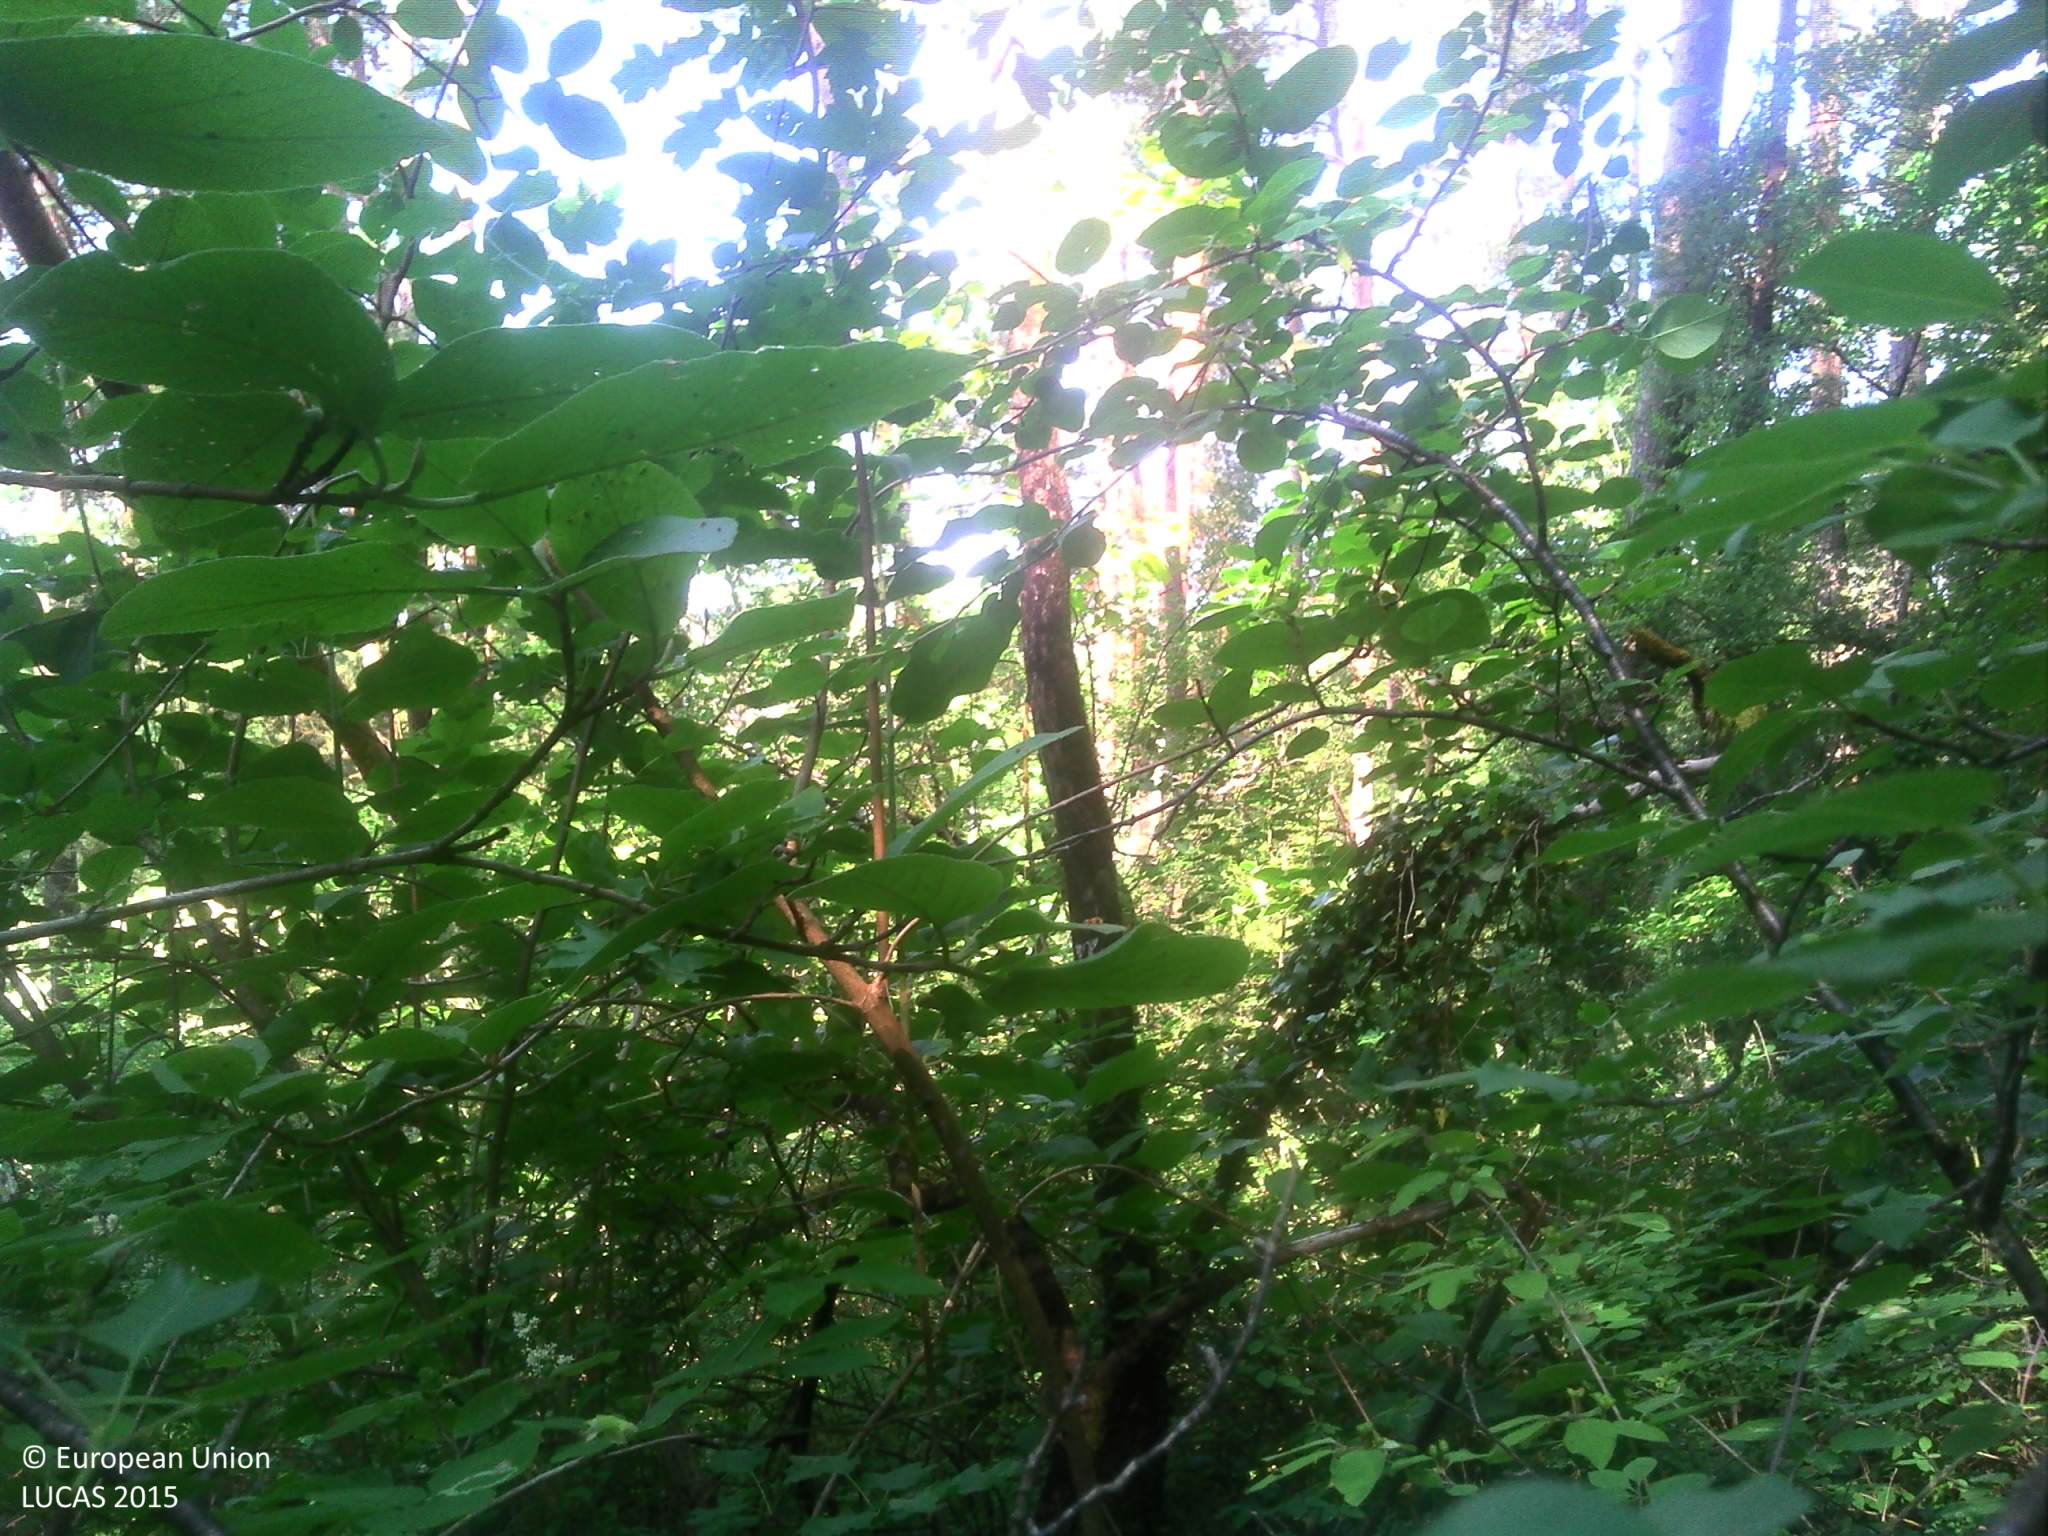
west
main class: Woodland
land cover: Pine dominated coniferous woodland
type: beech forest
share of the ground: > 75 %
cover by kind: coniferous forest trees 70 %, broadleaved forest trees 20 %, herbaceous plants 5 %, lichens and mosses 5 %
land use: Forestry
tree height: > 5 m
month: June
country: FR
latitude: 48.3705
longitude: 5.1797
